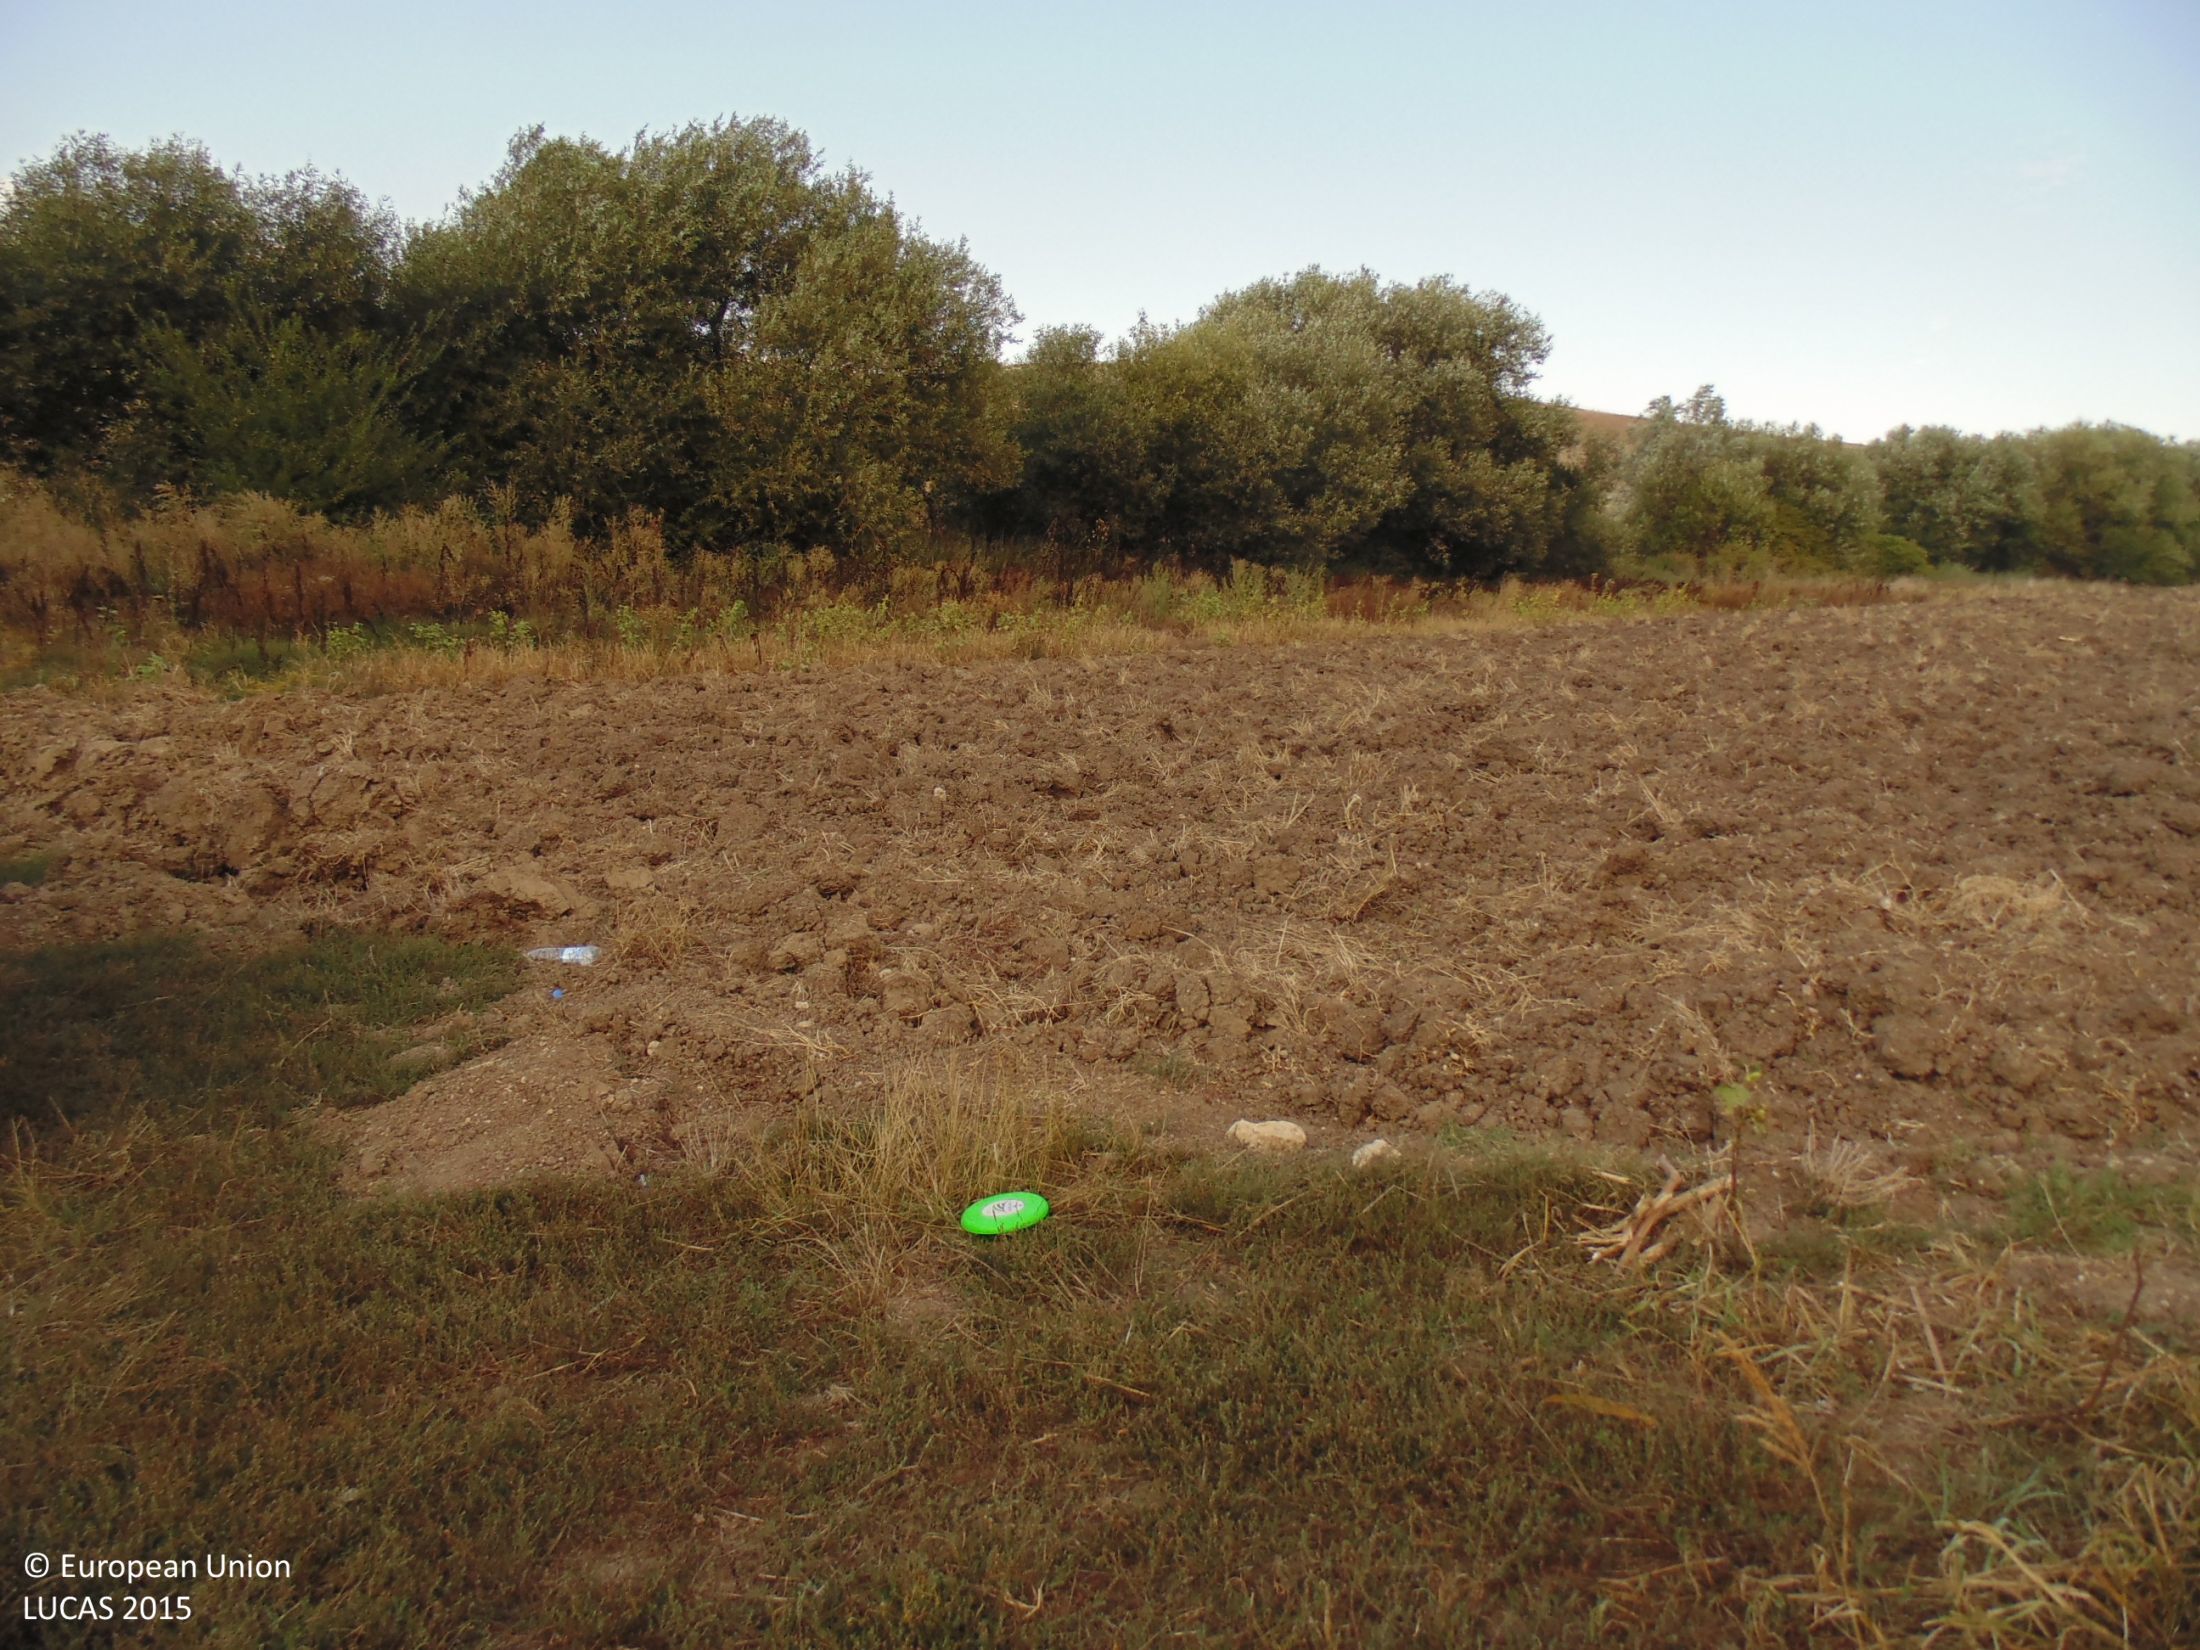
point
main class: Cropland
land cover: Common wheat
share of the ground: < 10 %
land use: Agriculture (excluding fallow land and kitchen gardens)
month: September
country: BG
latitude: 44.0701
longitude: 27.1459
